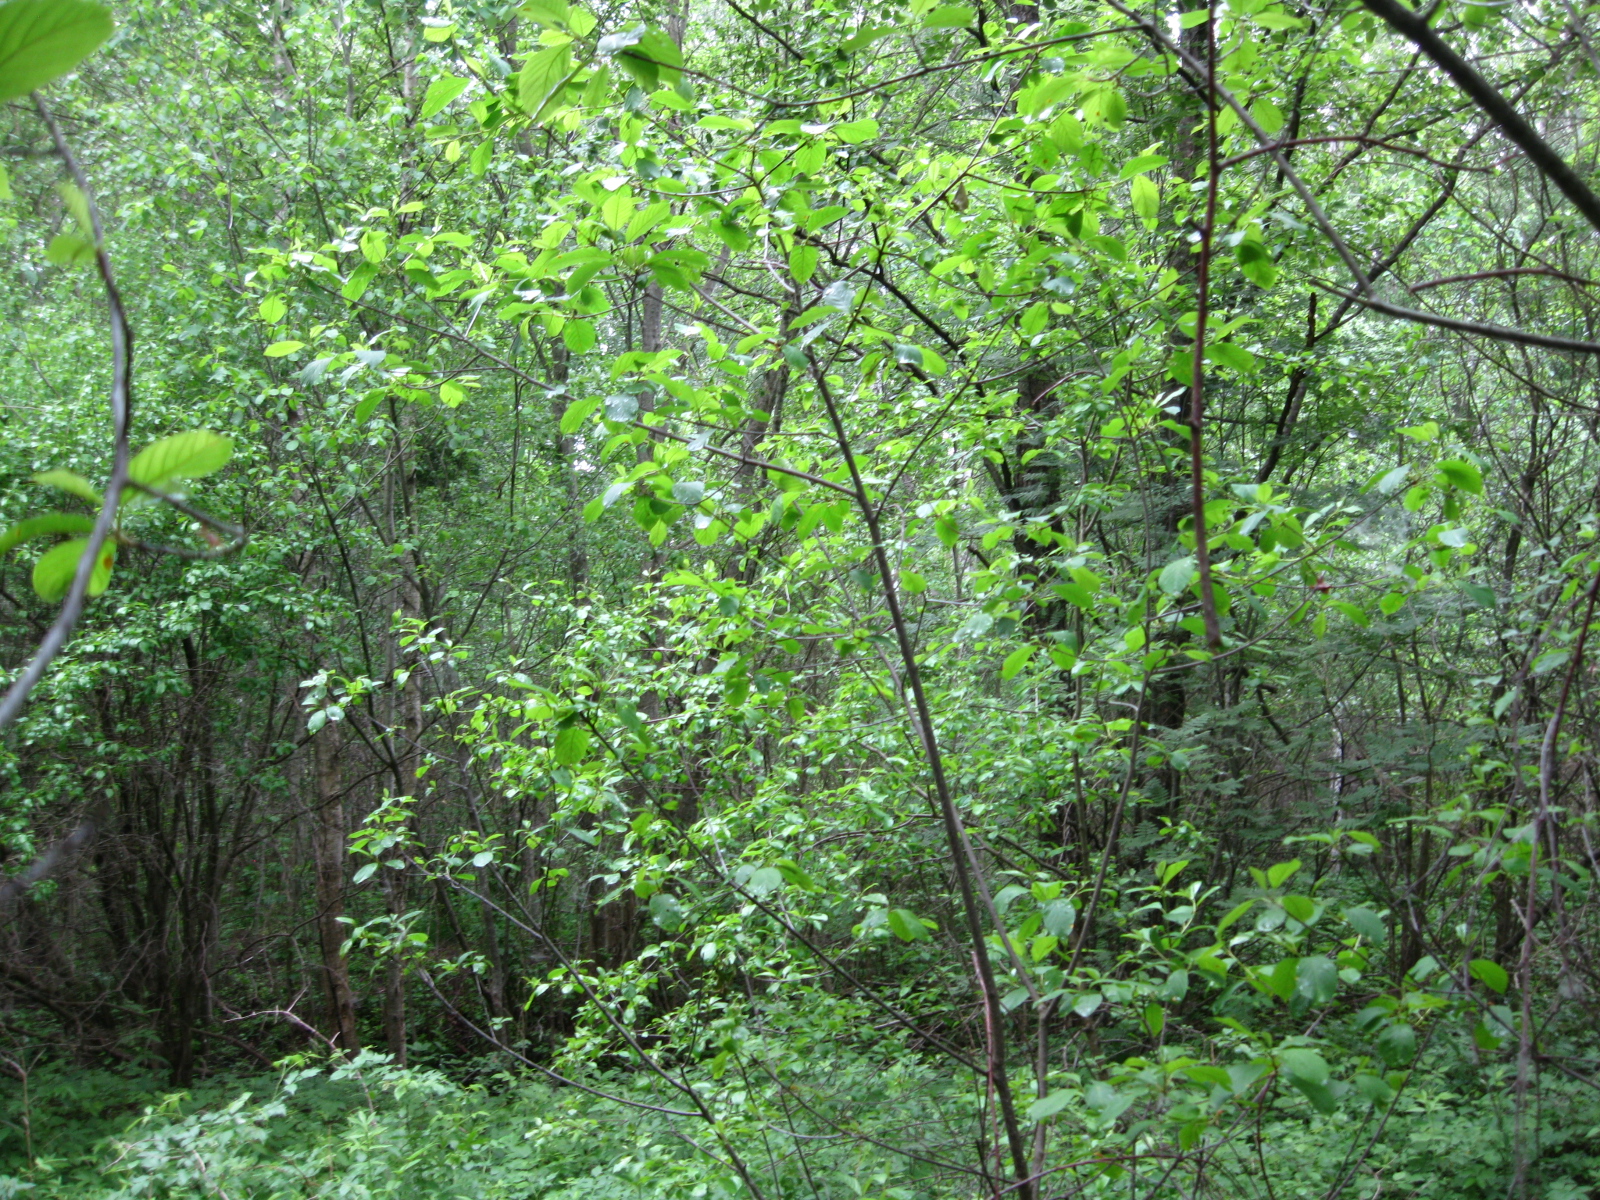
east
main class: Woodland
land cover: Broadleaved woodland
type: non-riverine alder, birch or aspen forest
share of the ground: > 75 %
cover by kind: broadleaved forest trees 80 %, herbaceous plants 15 %, shrubs 5 %
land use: Forestry
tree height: > 5 m
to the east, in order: Broadleaved woodland; Ditches and canals; Broadleaved woodland
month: June
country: LT
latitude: 55.9169
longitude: 24.0898
